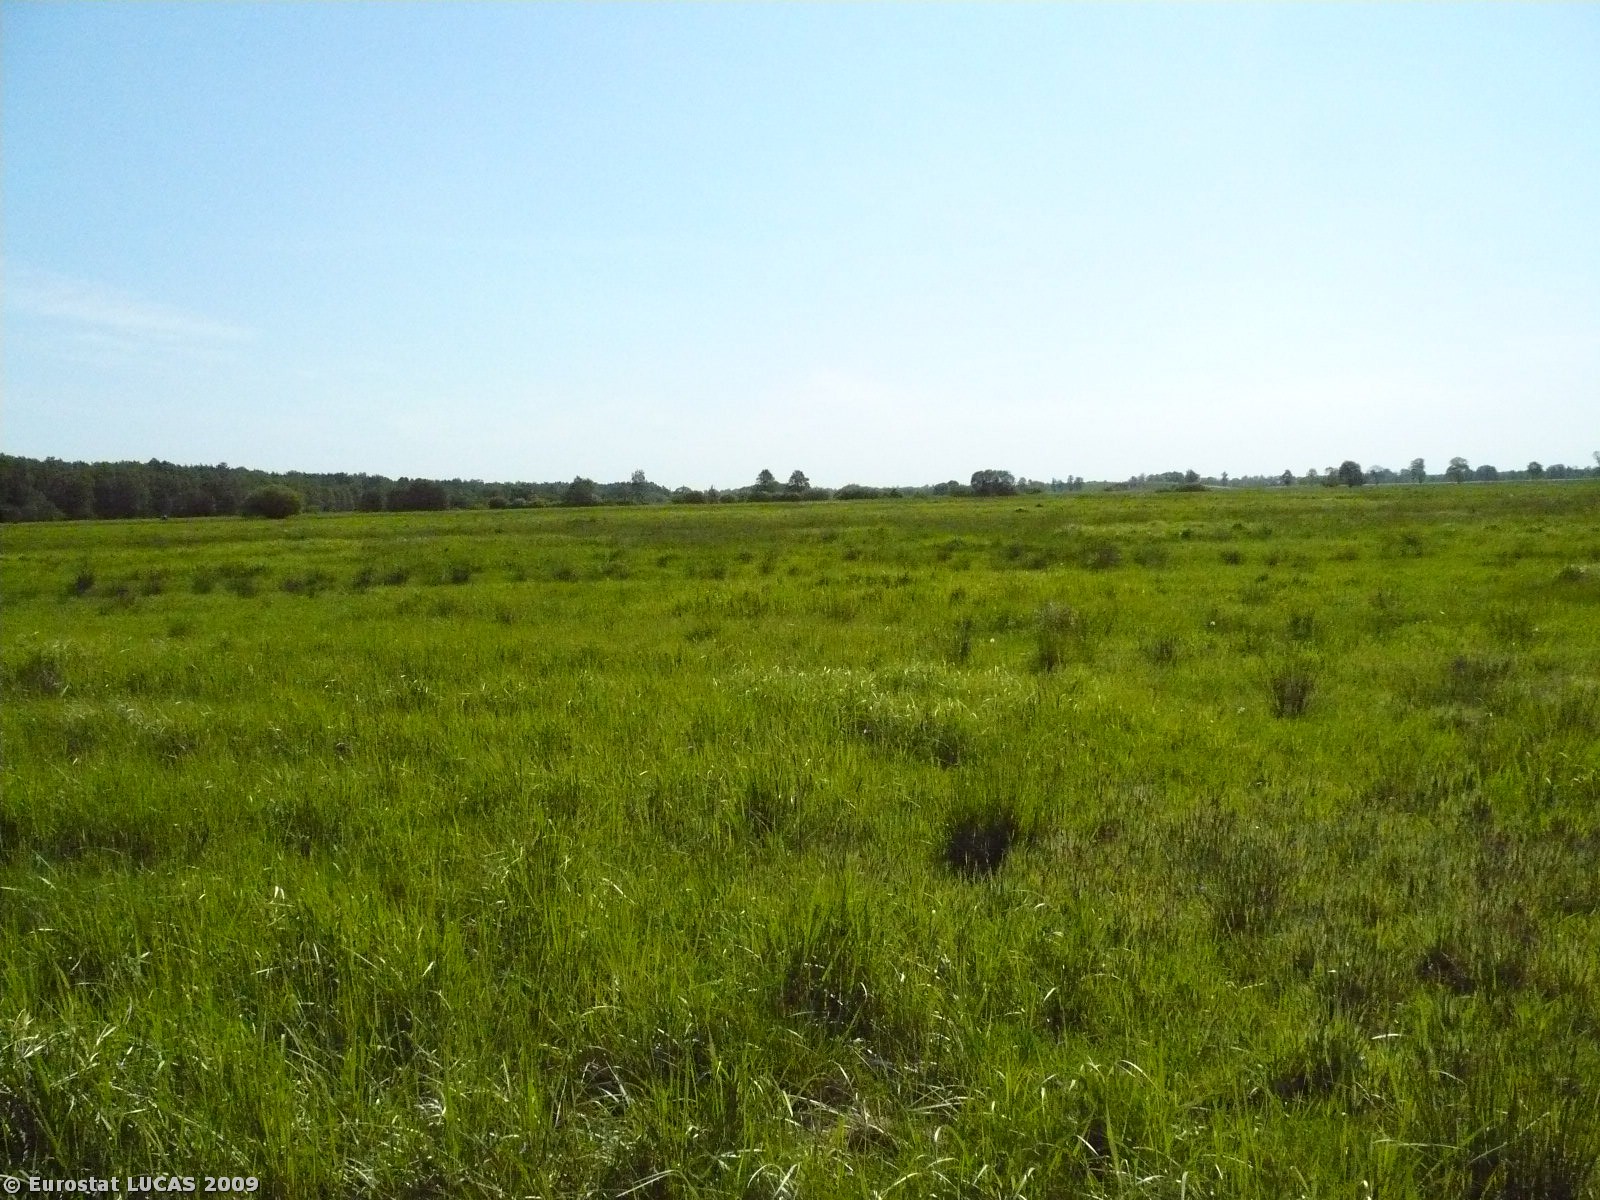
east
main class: Grassland
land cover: Grassland without tree/shrub cover
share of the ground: > 75 %
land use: Agriculture (excluding fallow land and kitchen gardens)
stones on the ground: < 10 %
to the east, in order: Grassland without tree/shrub cover; Ditches and canals; Grassland without tree/shrub cover; Ditches and canals; Grassland without tree/shrub cover
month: May
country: PL
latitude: 51.8465
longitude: 15.6514
